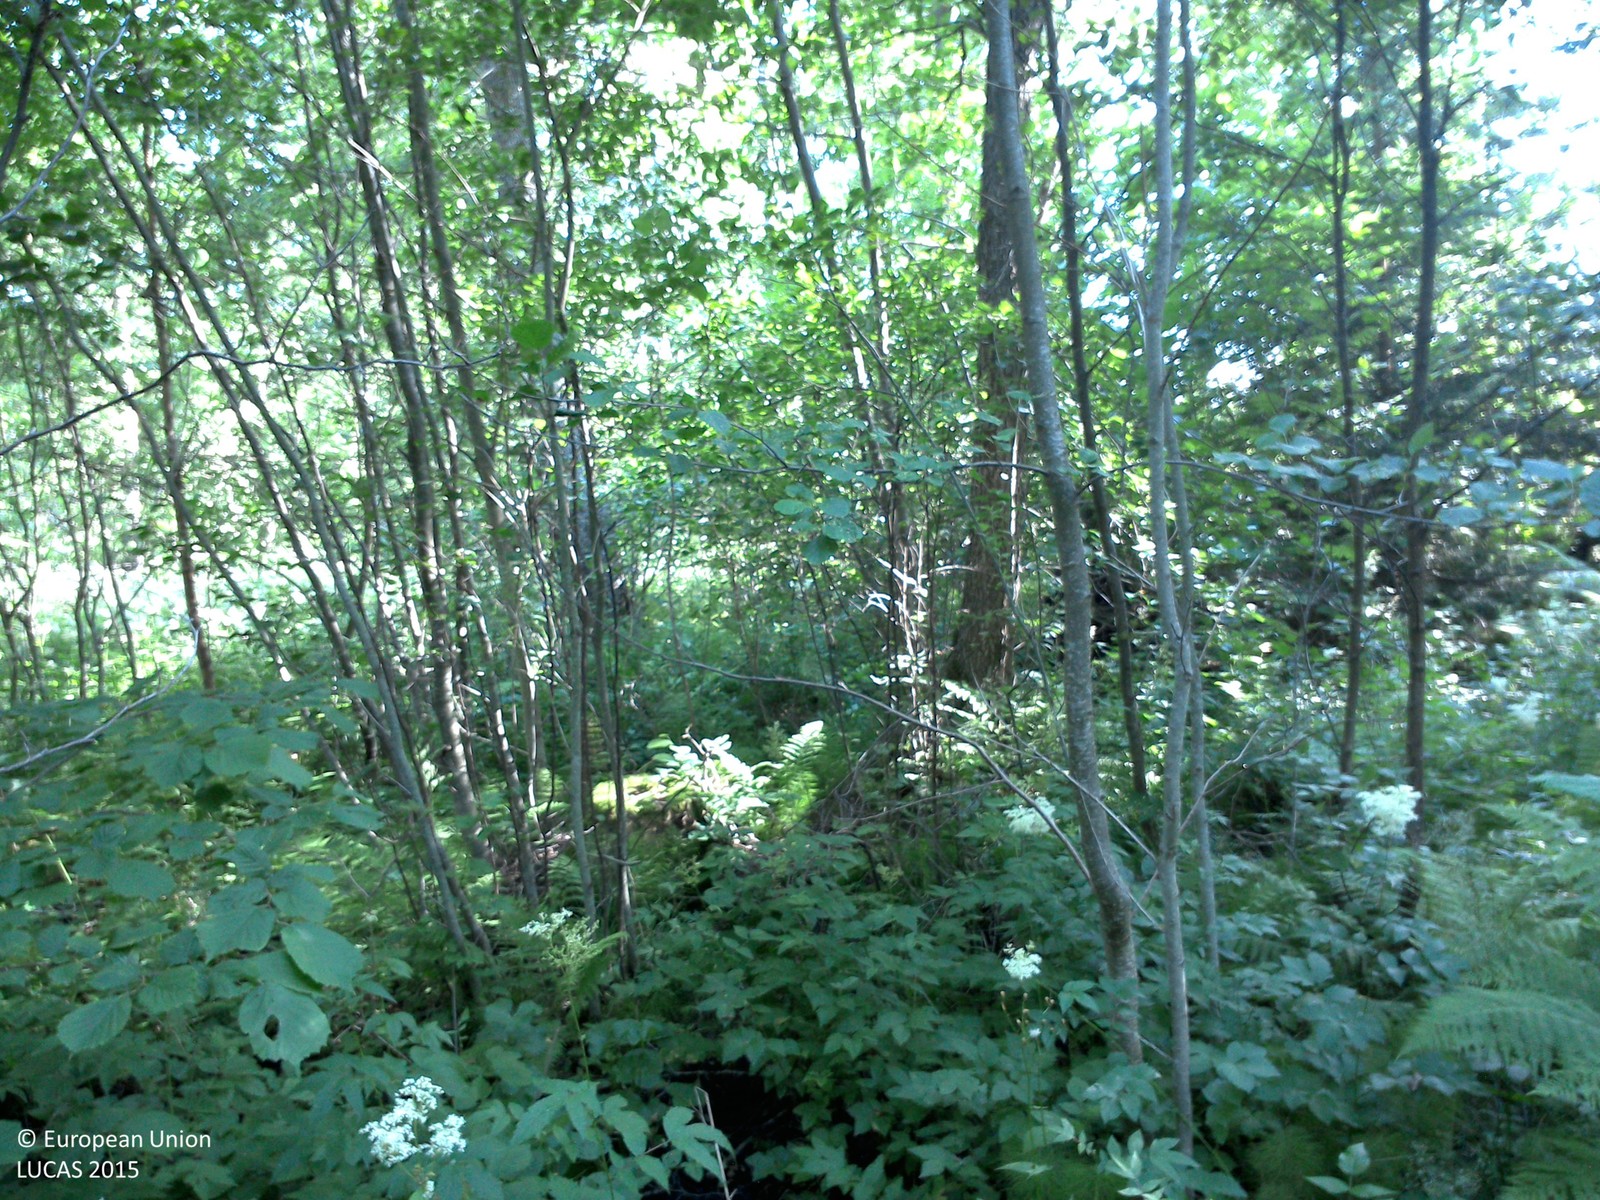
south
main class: Woodland
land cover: Broadleaved woodland
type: boreal forest
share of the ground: > 75 %
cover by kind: broadleaved forest trees 80 %, herbaceous plants 20 %
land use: Forestry
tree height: > 5 m
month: July
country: SE
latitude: 57.9675
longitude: 14.9140
